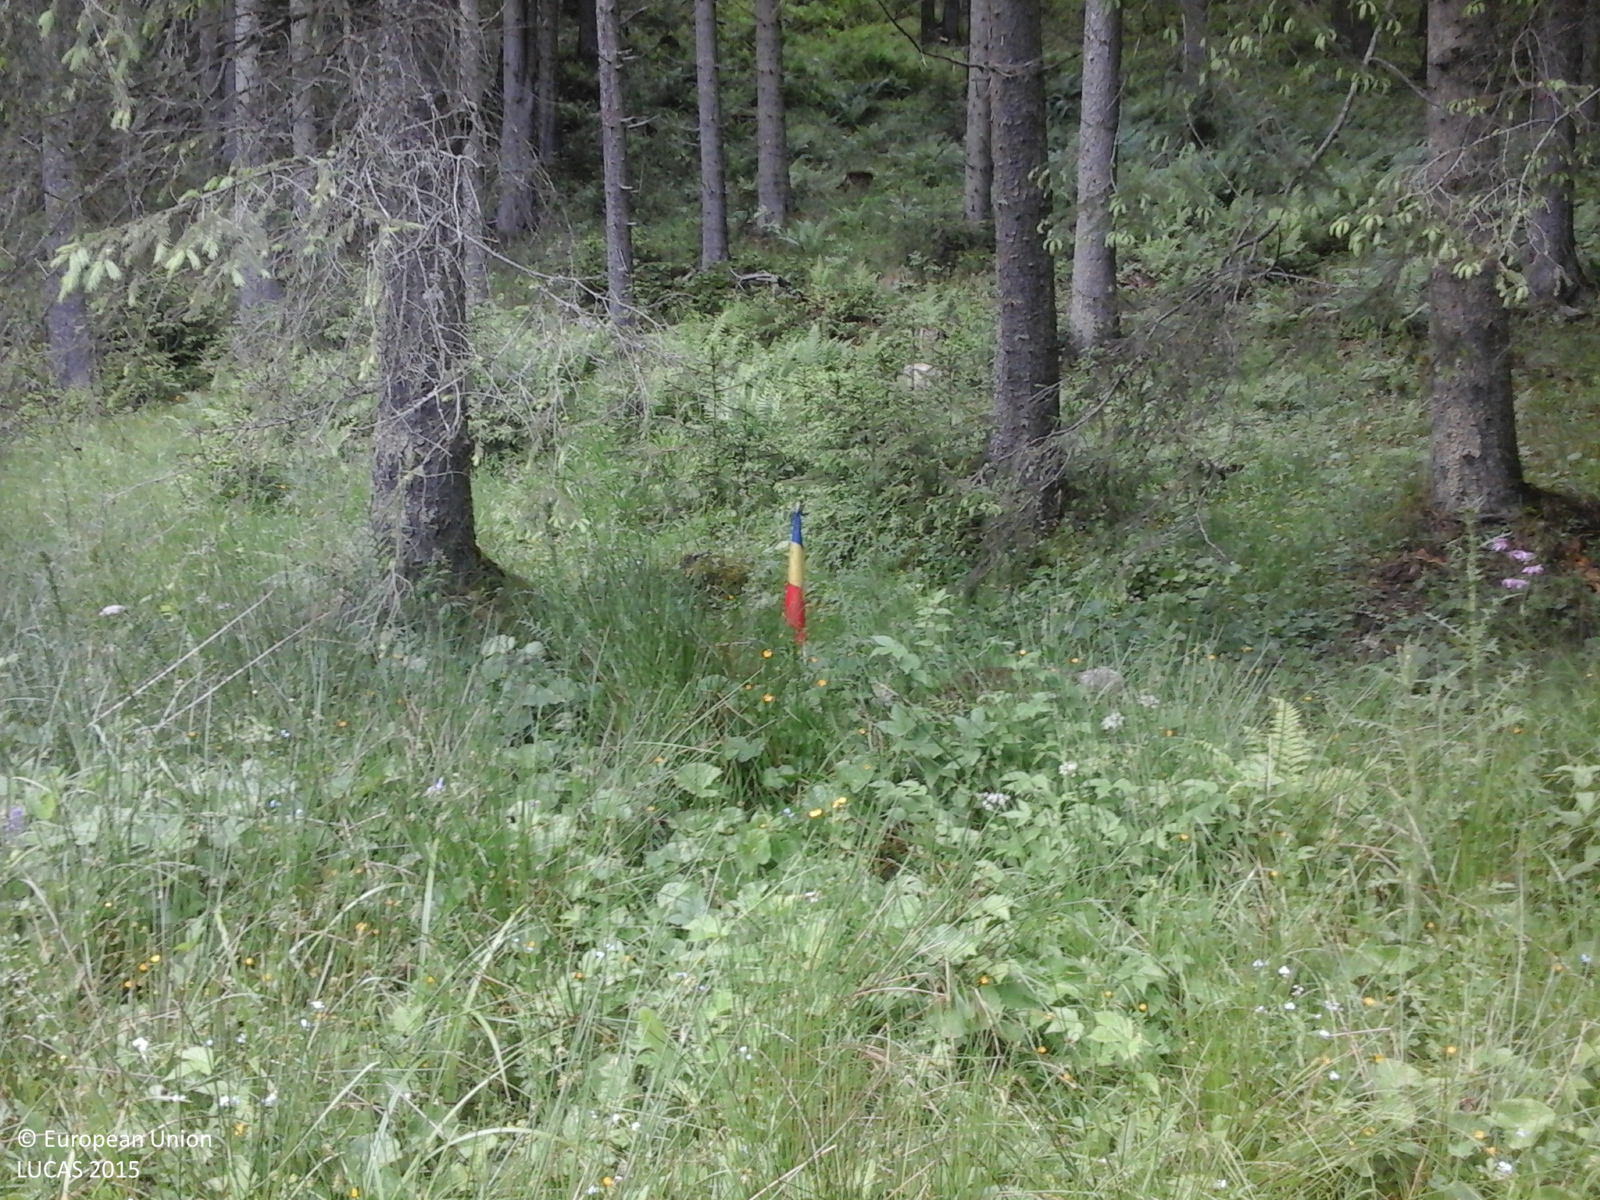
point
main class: Woodland
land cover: Spruce dominated coniferous woodland
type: alpine coniferous forest
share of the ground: > 75 %
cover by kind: coniferous forest trees 85 %, herbaceous plants 10 %, shrubs 5 %
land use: Forestry
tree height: > 5 m
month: June
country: RO
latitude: 47.4208
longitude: 25.1792
